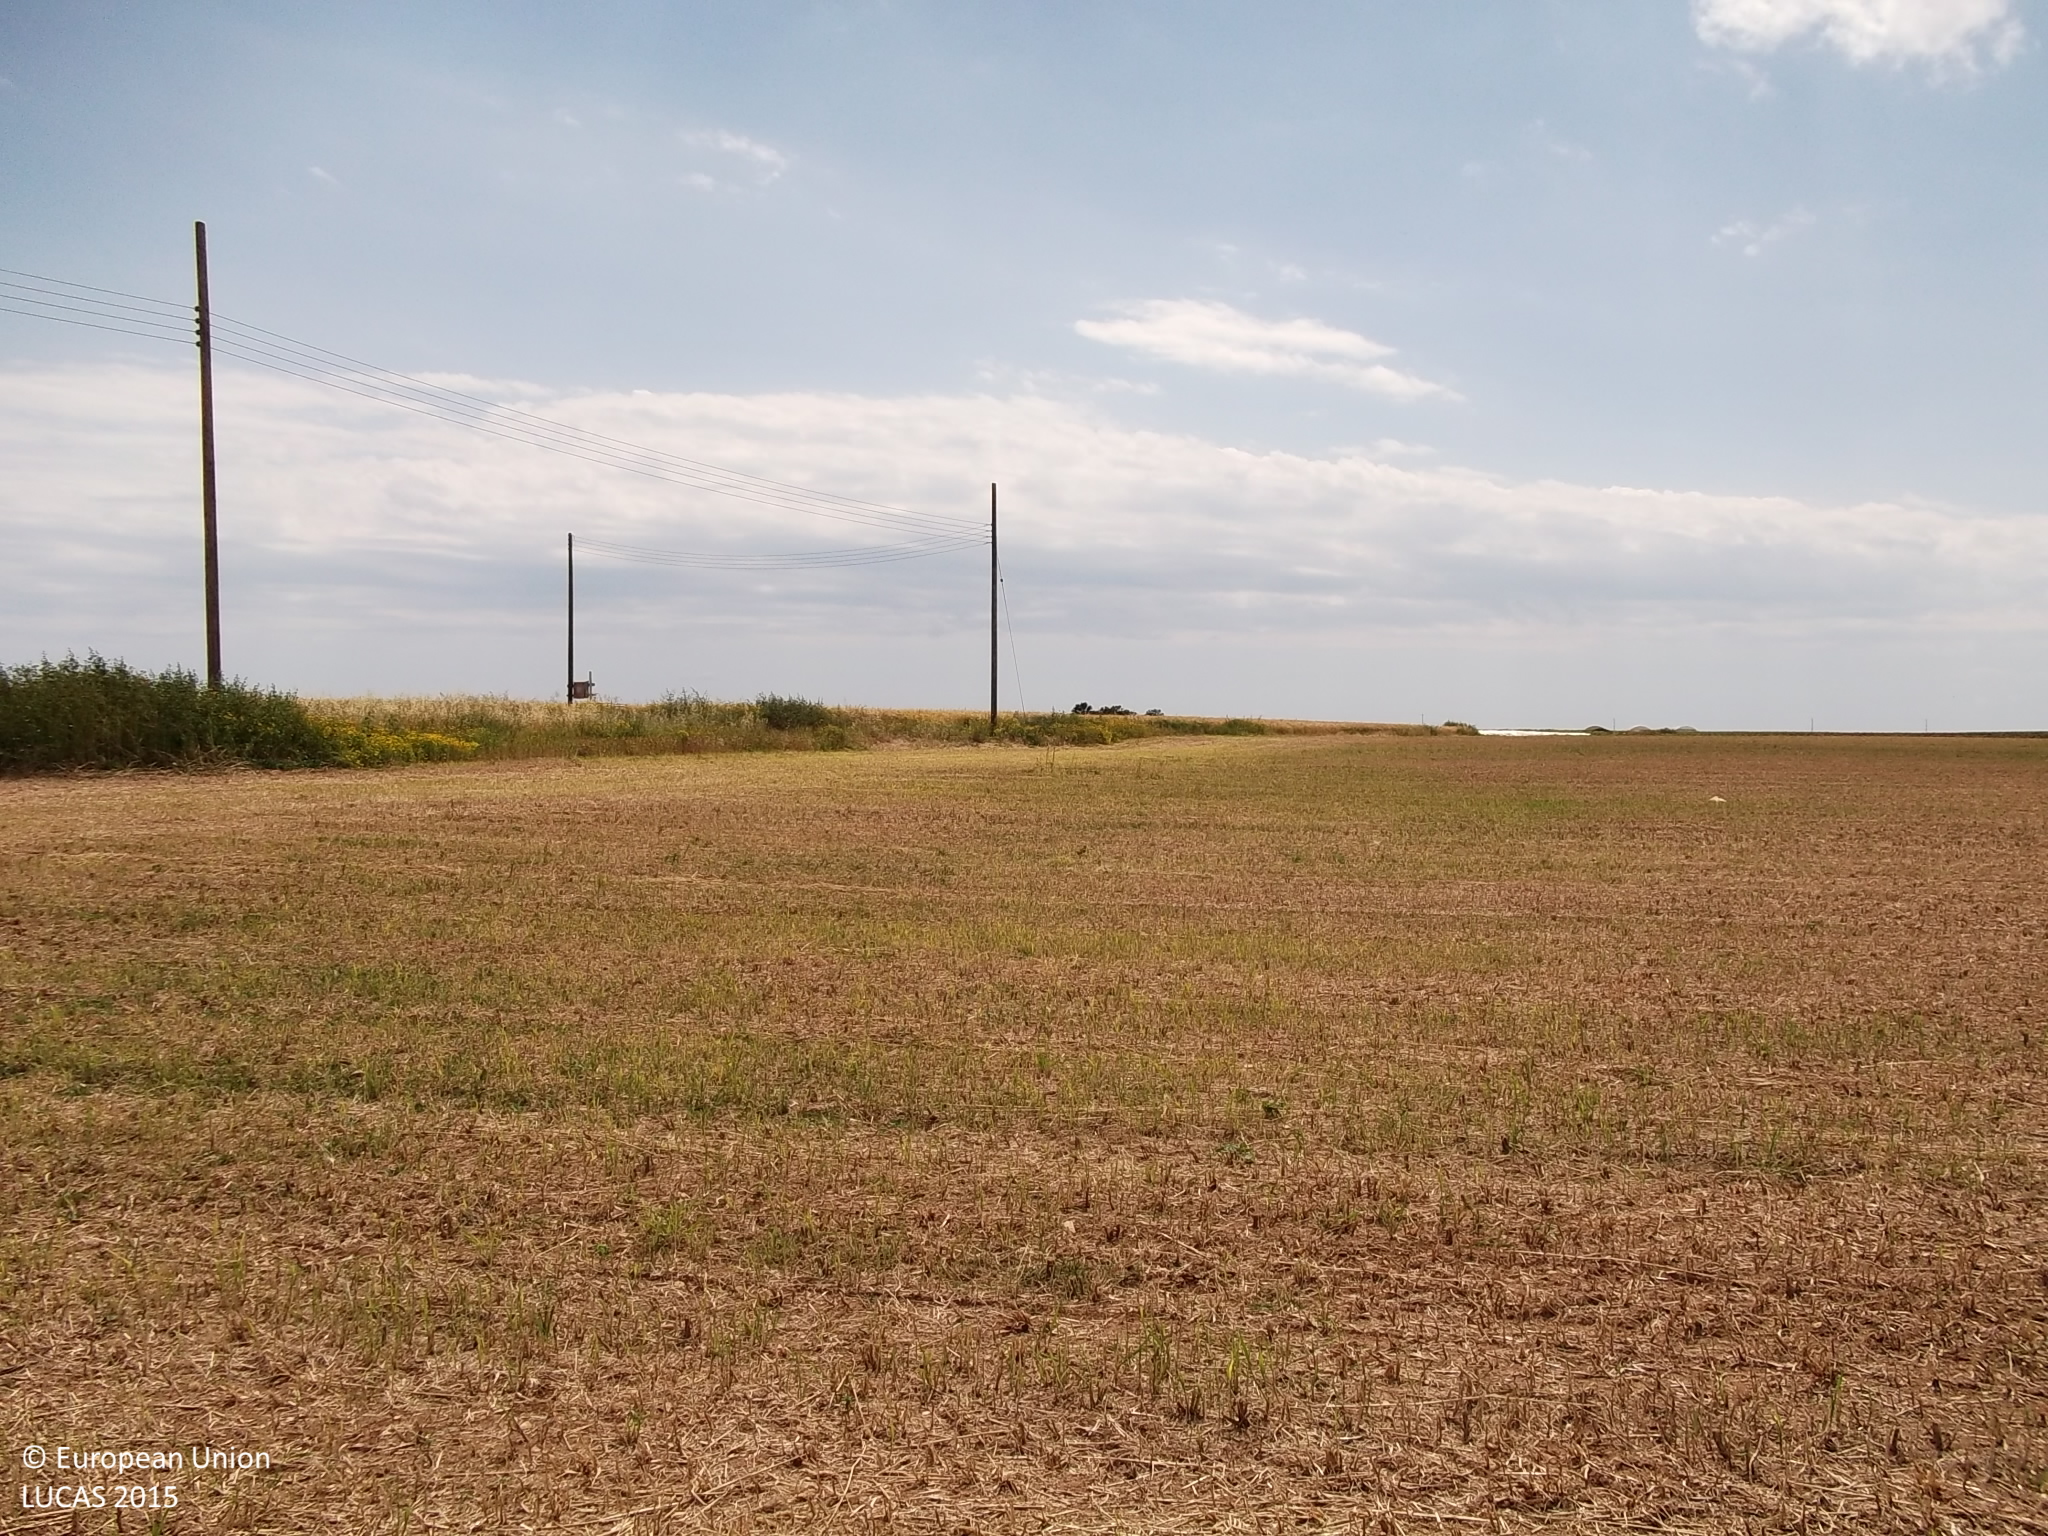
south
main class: Cropland
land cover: Common wheat
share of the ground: < 10 %
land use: Agriculture (excluding fallow land and kitchen gardens)
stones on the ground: < 10 %
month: April
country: CY
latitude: 34.8251
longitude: 33.5324
